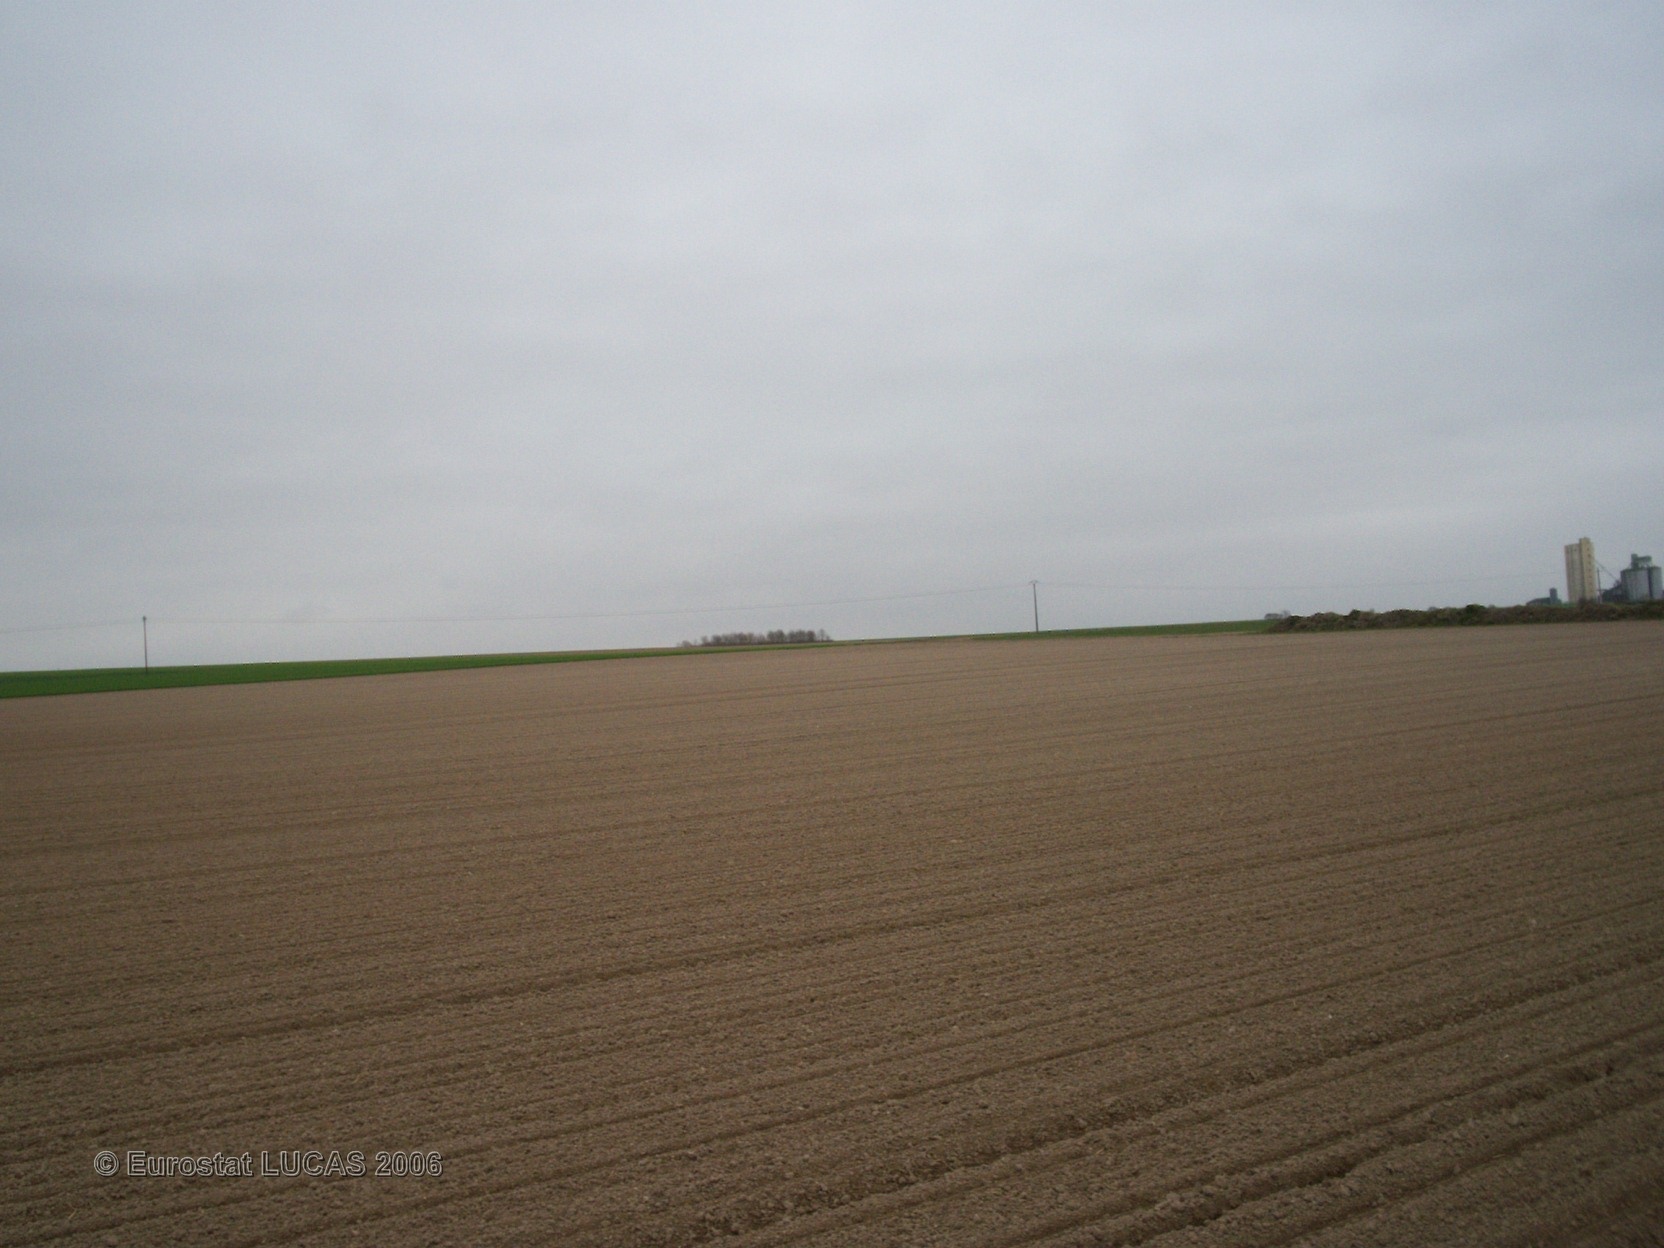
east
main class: Cropland
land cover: Sugar beet
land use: Agriculture (excluding fallow land and kitchen gardens)
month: June
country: FR
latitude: 49.2536
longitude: 4.4044
